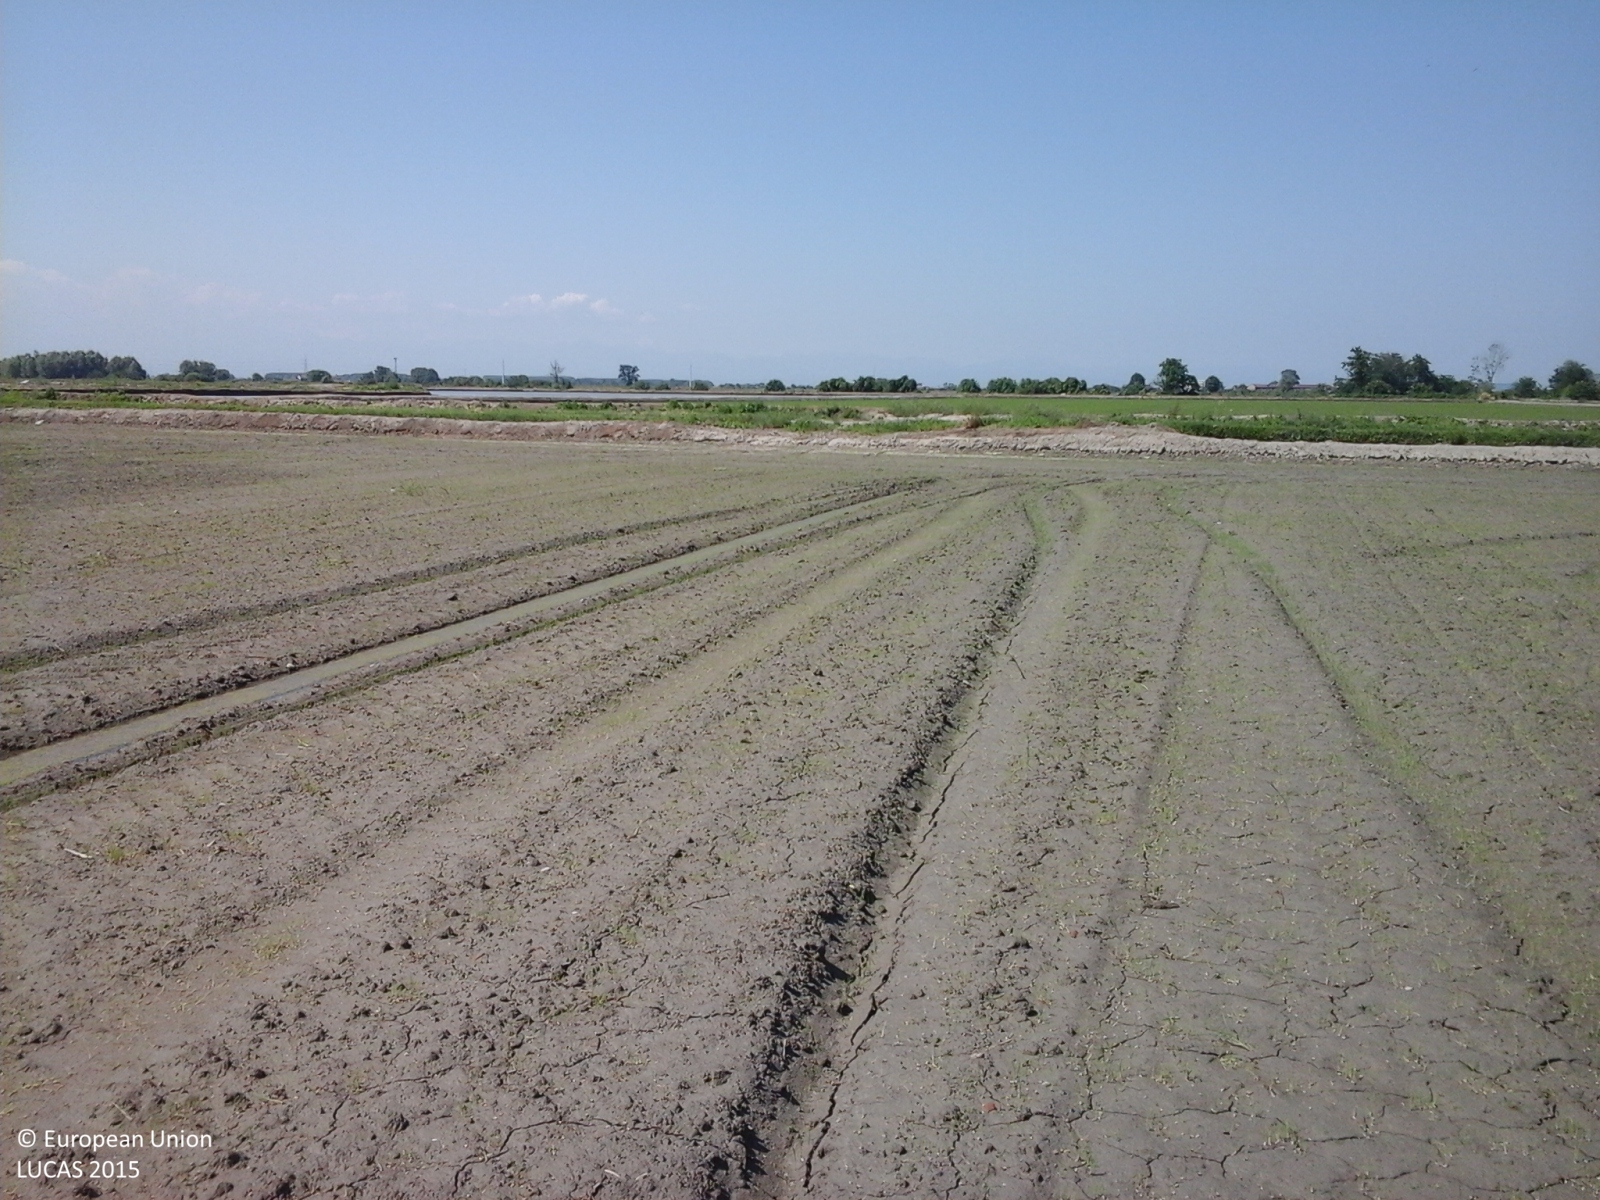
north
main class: Cropland
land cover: Rice
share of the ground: < 10 %
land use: Agriculture (excluding fallow land and kitchen gardens)
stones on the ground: < 10 %
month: May
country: IT
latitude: 45.2577
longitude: 8.3845
